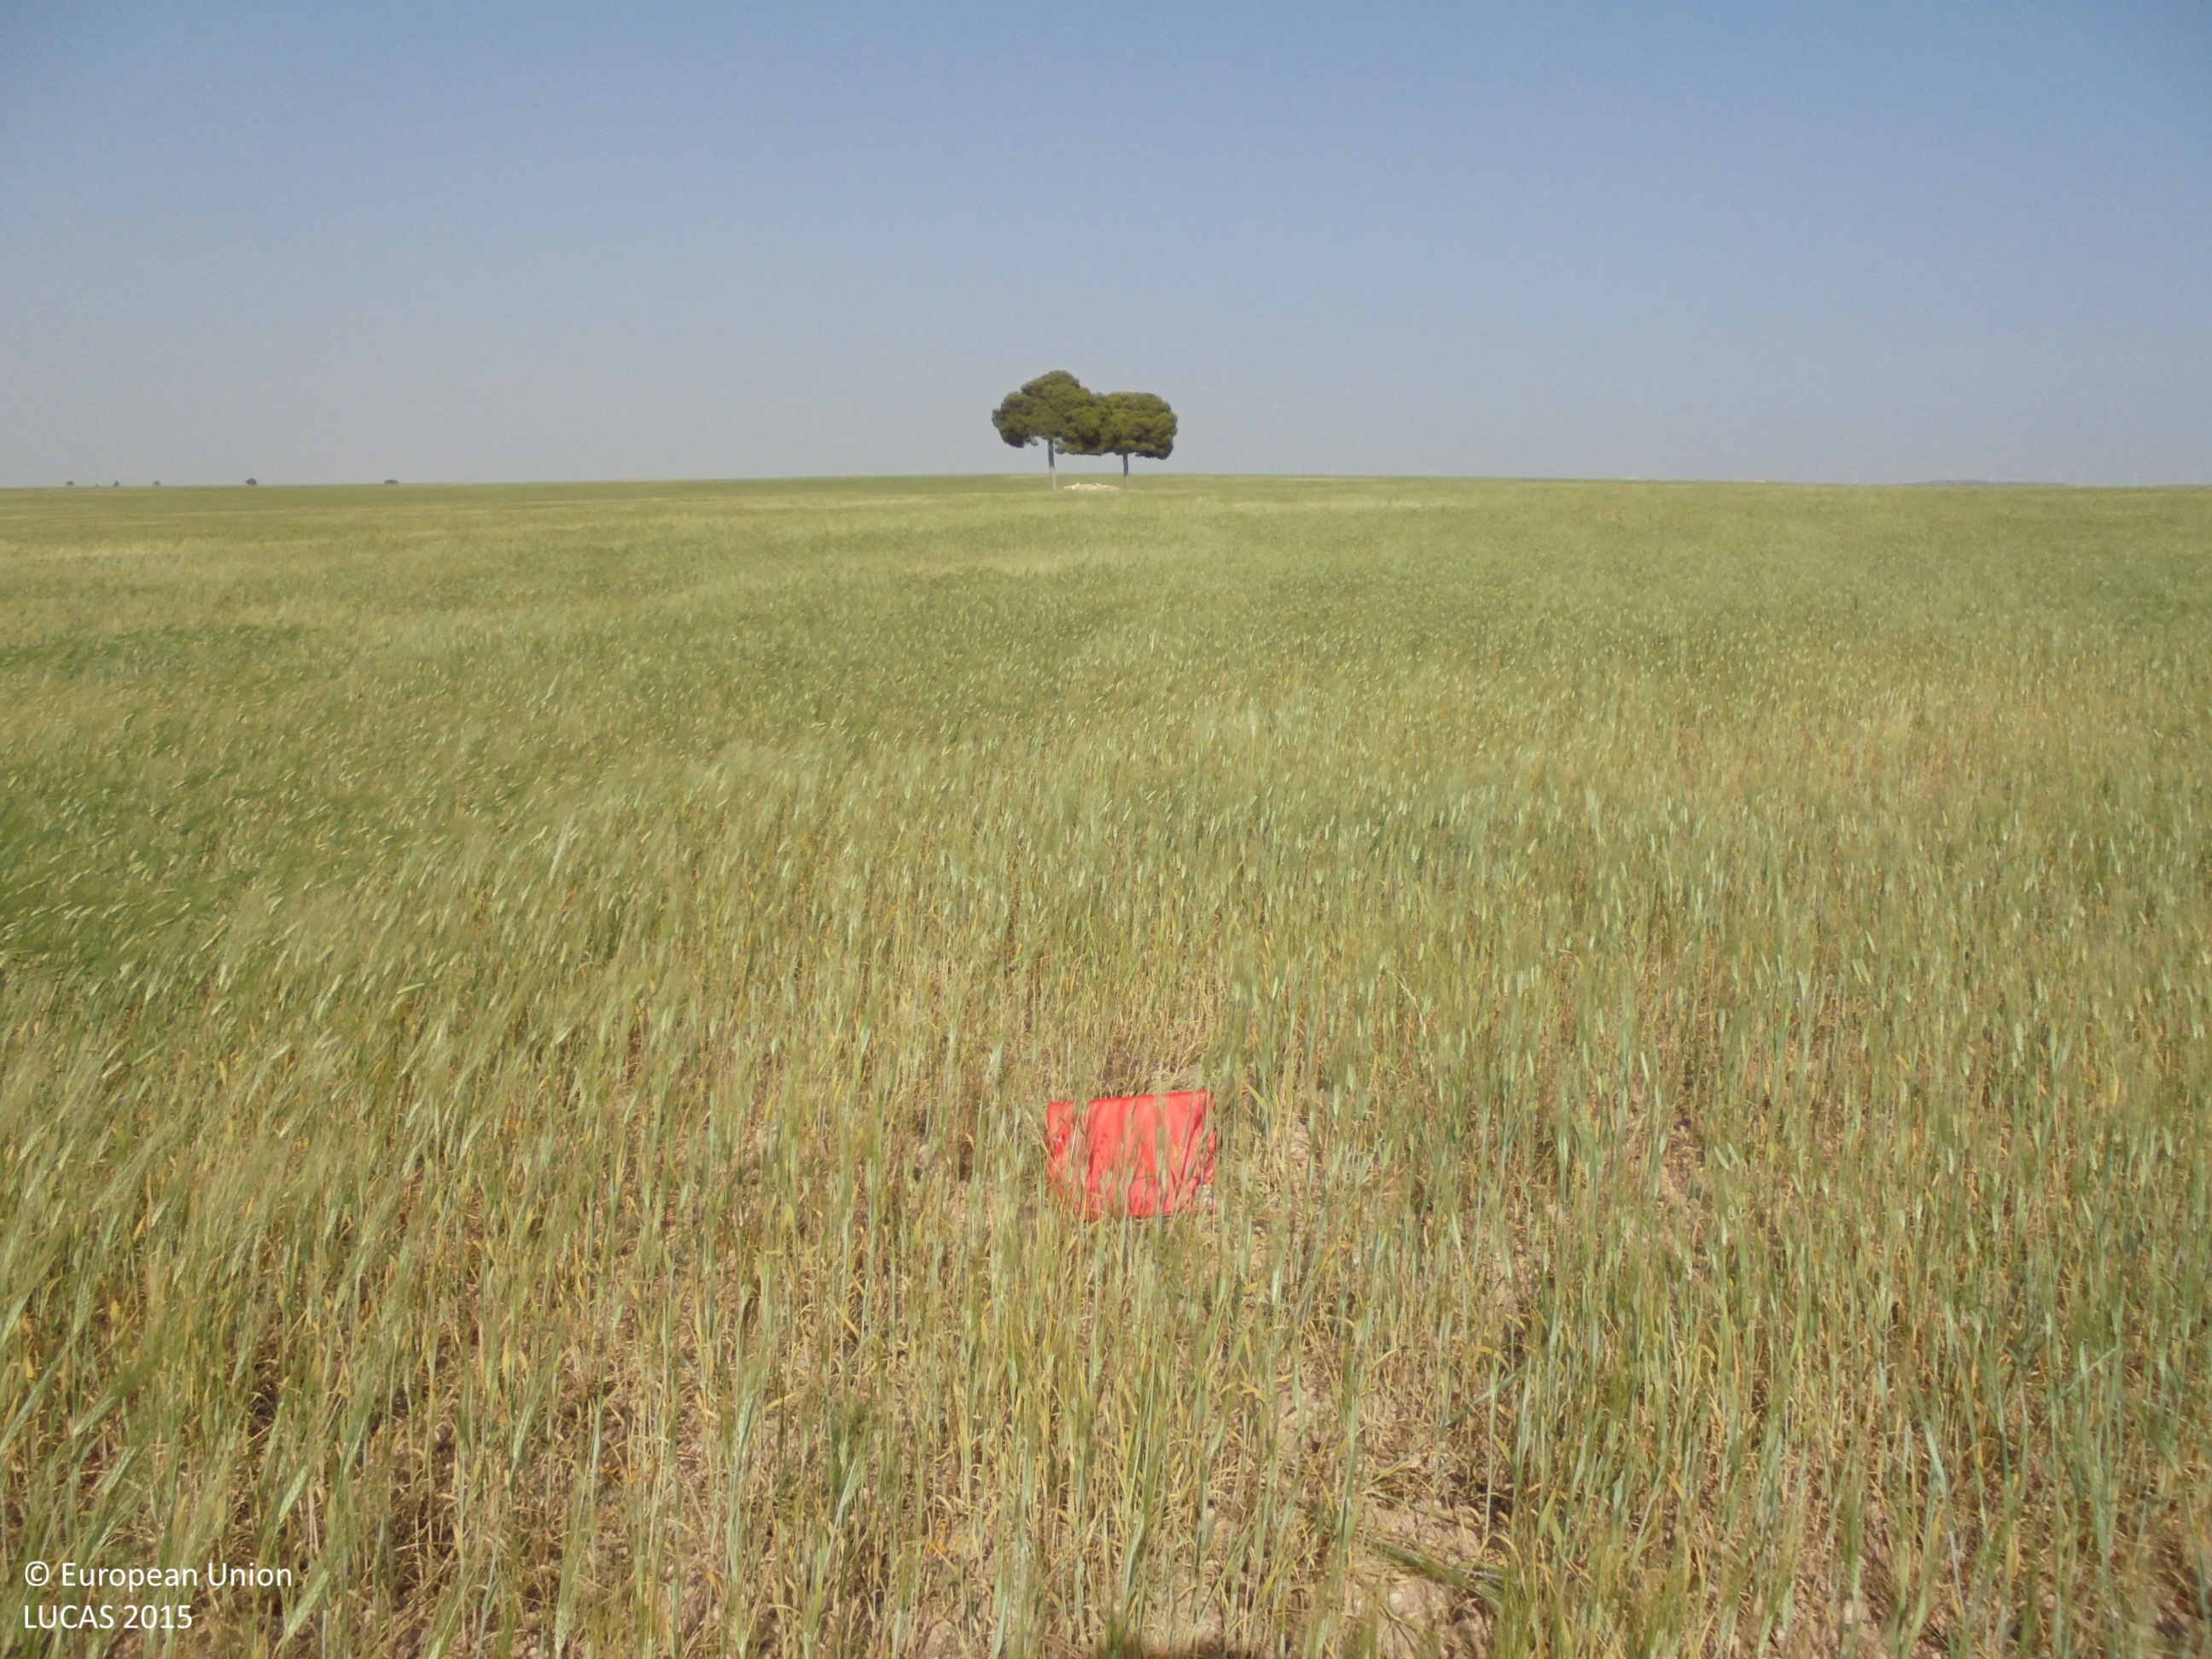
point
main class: Cropland
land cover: Barley
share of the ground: 25 - 50 %
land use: Agriculture (excluding fallow land and kitchen gardens)
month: May
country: ES
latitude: 39.0814
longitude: -1.6176
